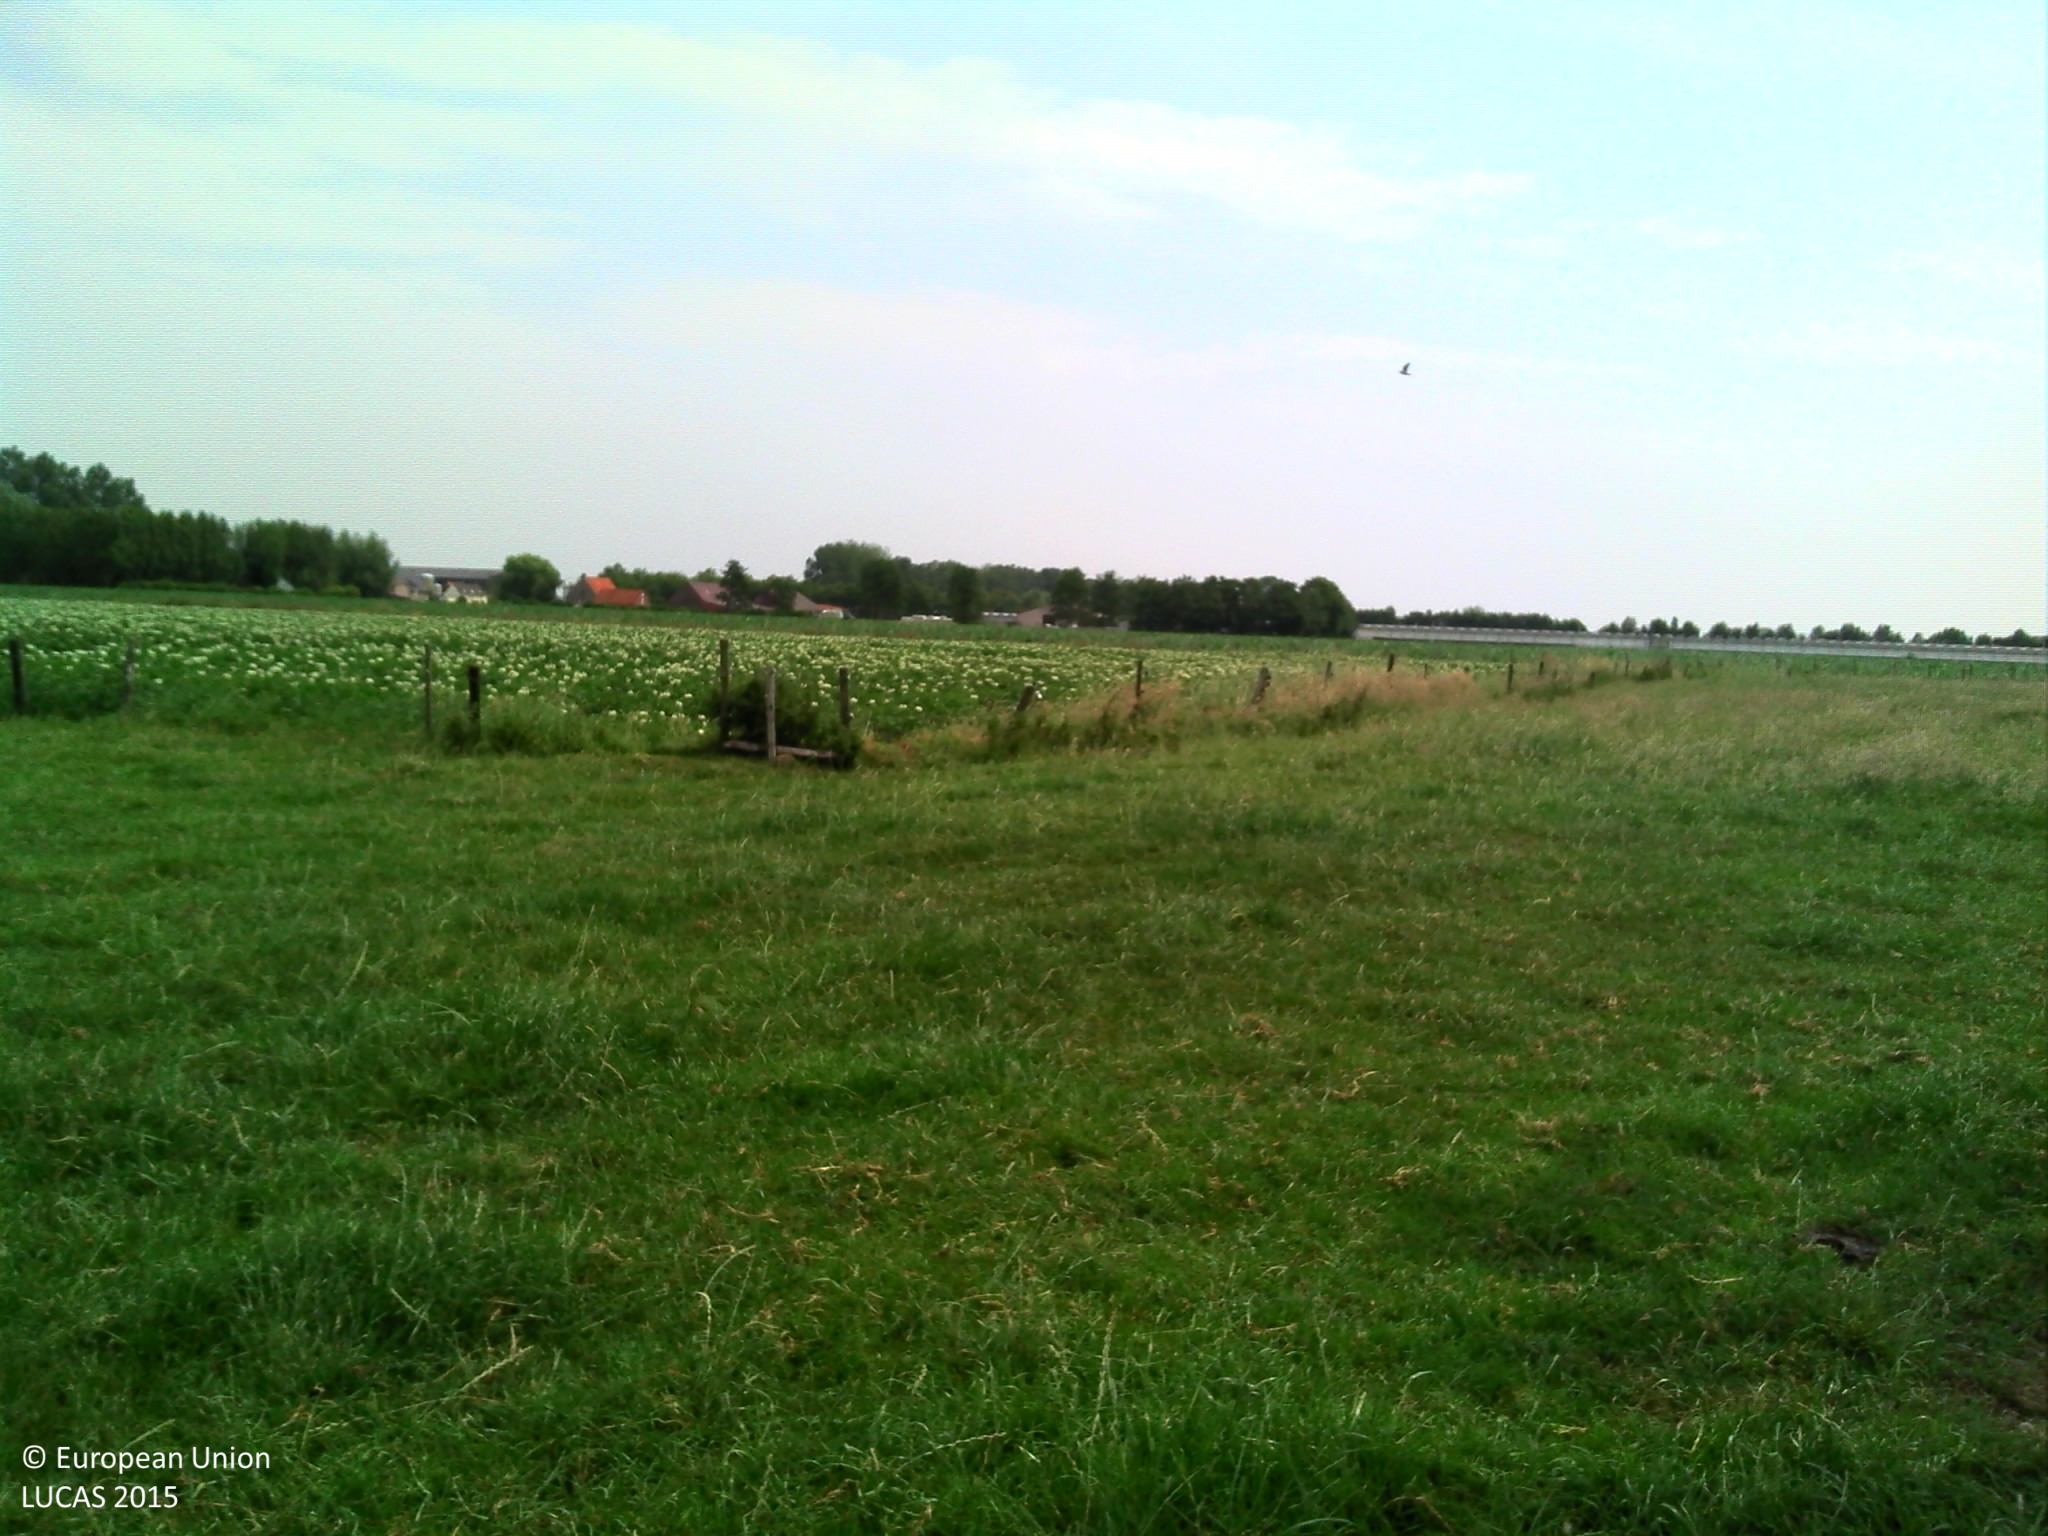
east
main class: Grassland
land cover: Grassland without tree/shrub cover
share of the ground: > 75 %
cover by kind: herbaceous plants 100 %
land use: Agriculture (excluding fallow land and kitchen gardens)
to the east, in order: Grassland without tree/shrub cover; Fences; Grass margins; Fences; Potatoes; Ditches and canals; Fences; Grassland without tree/shrub cover; Fences; Grass margins; Ditches and canals; Maize; Ditches and canals; Maize
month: July
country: BE
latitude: 51.2289
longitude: 3.5625
